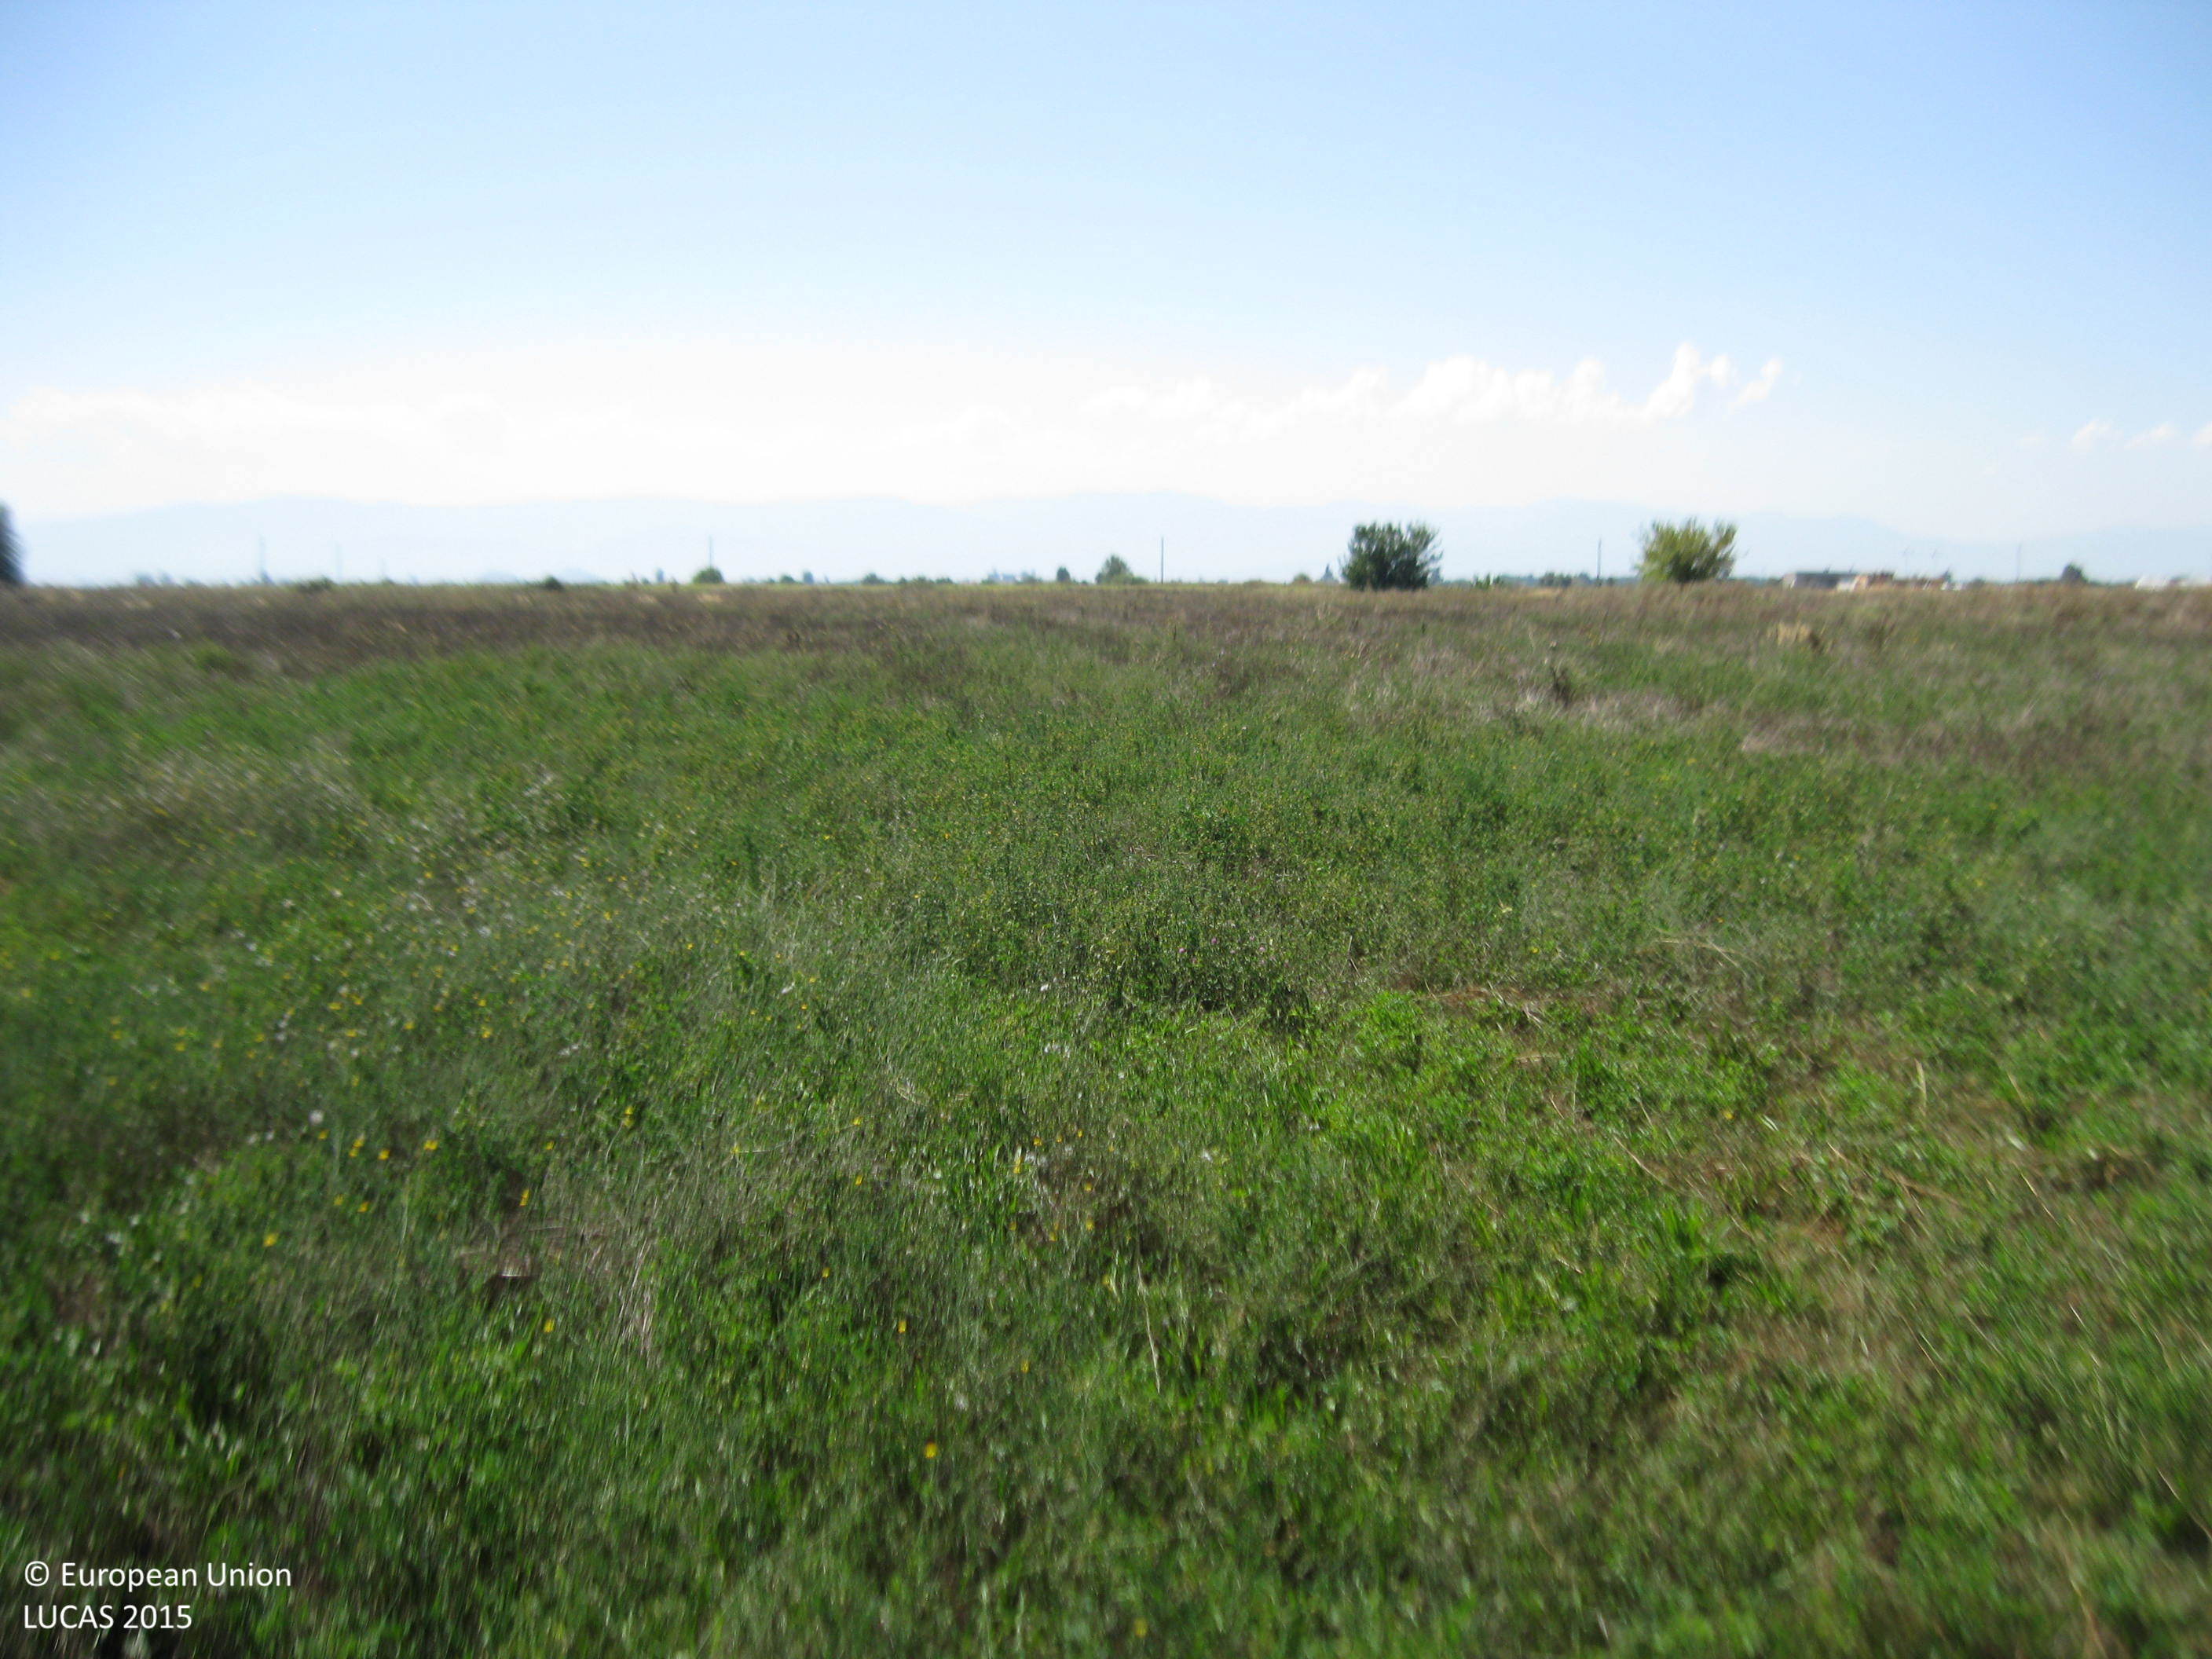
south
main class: Cropland
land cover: Lucerne
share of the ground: 50 - 75 %
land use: Agriculture (excluding fallow land and kitchen gardens)
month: September
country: BG
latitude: 42.2661
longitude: 24.7341
